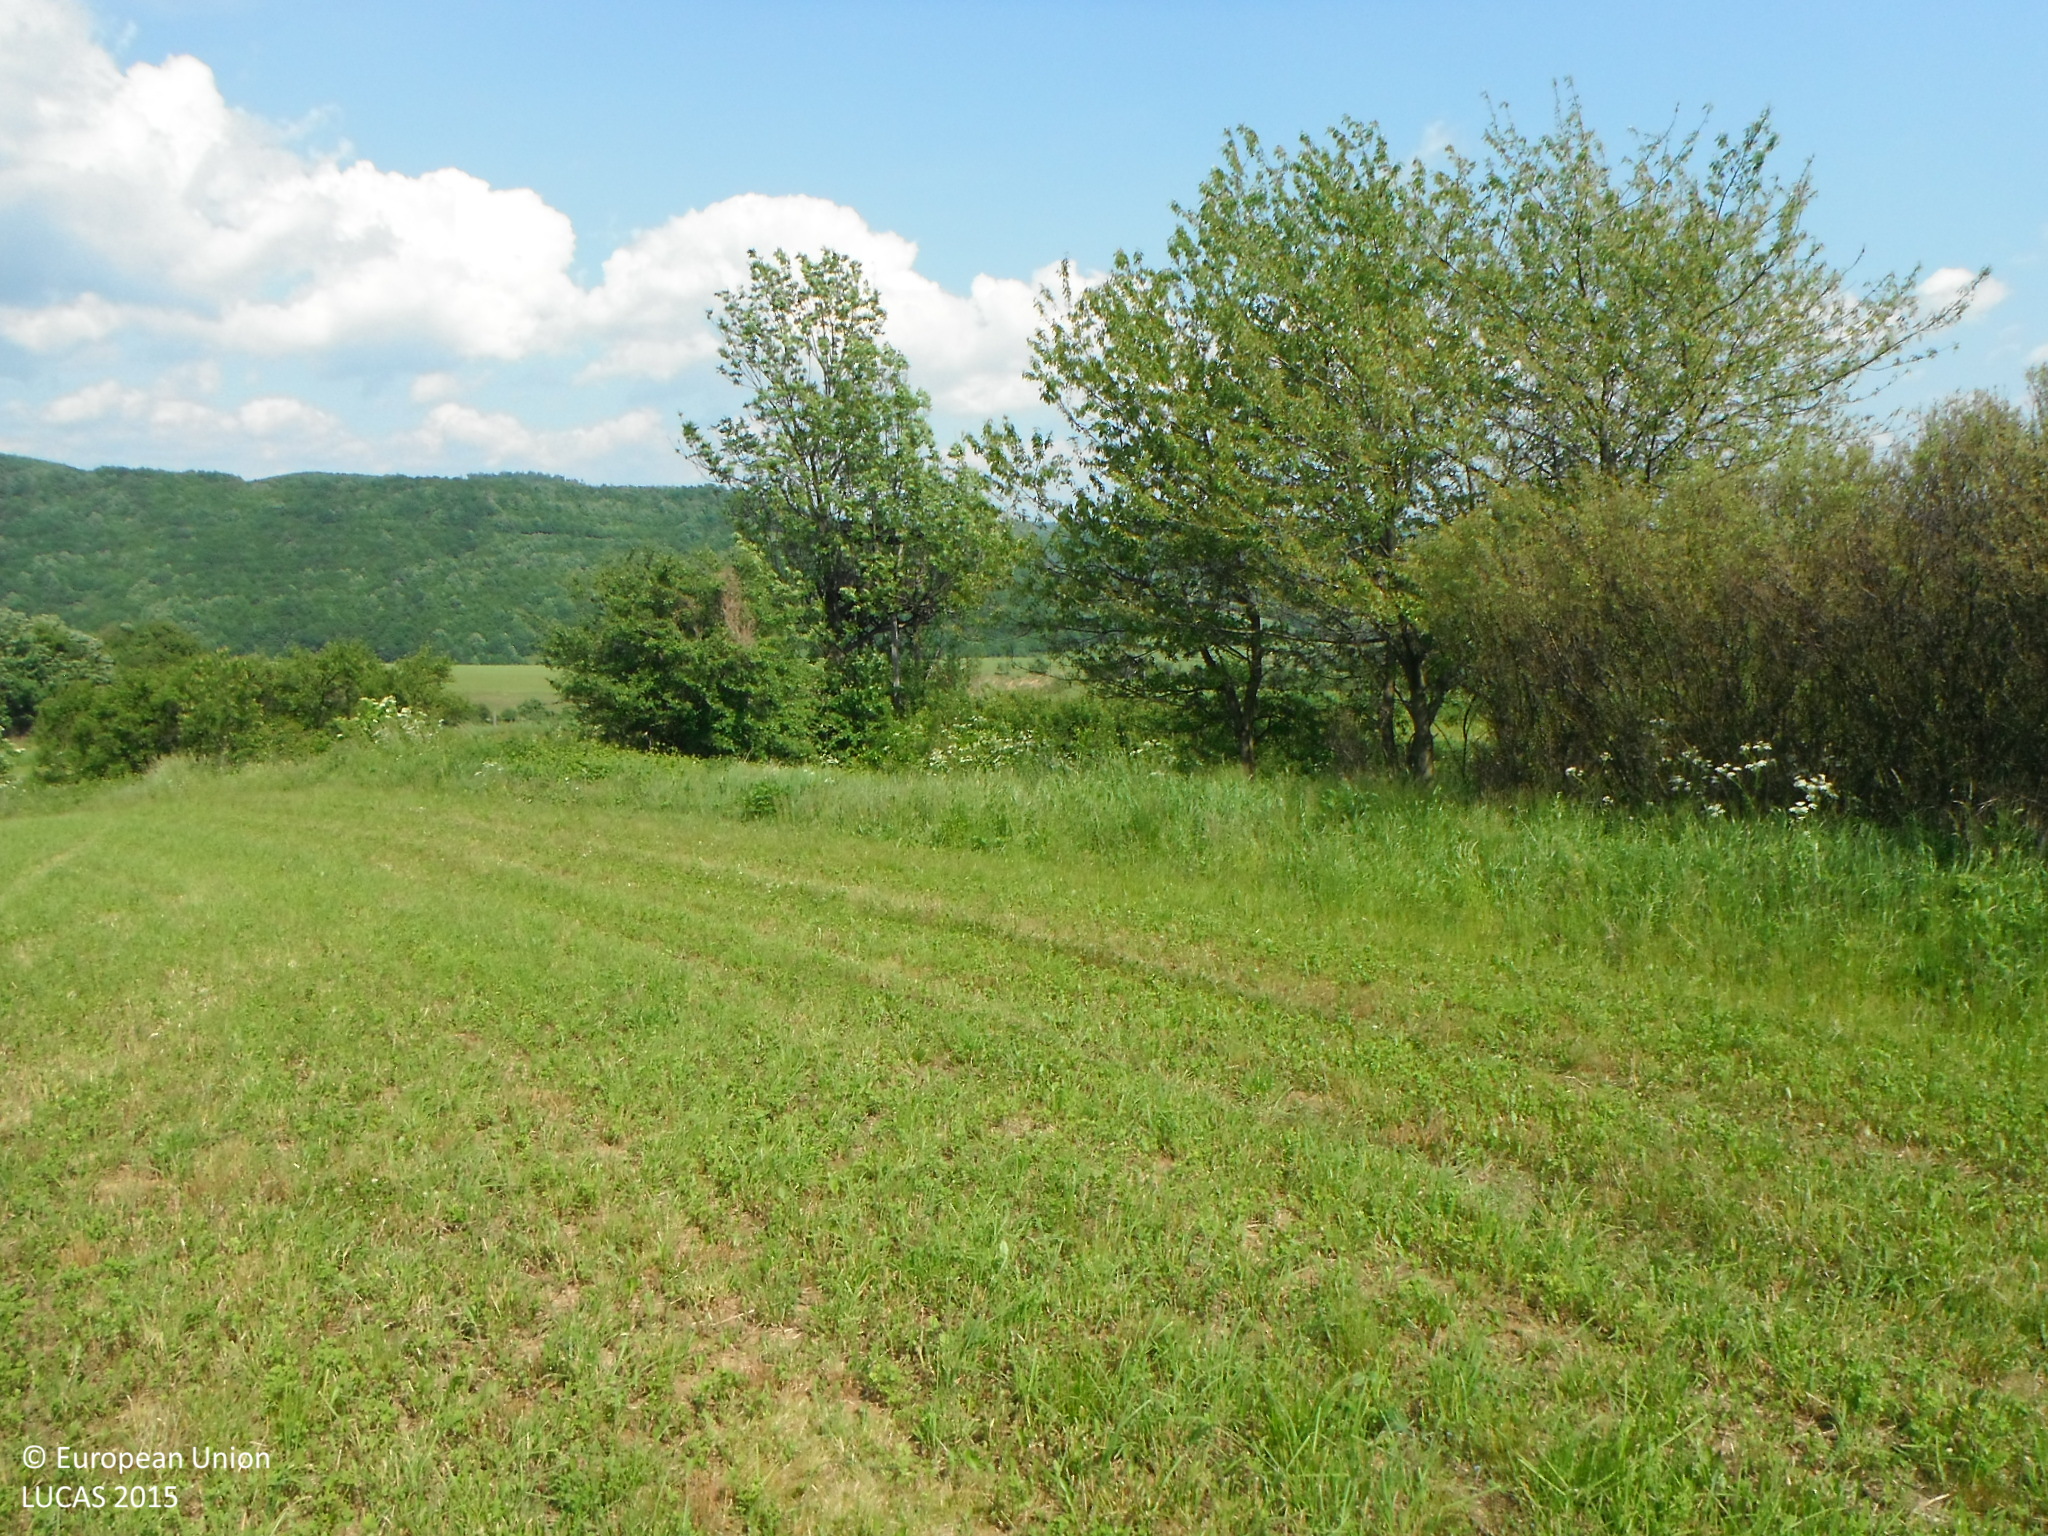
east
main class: Cropland
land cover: Other leguminous and mixtures for fodder
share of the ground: > 75 %
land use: Agriculture (excluding fallow land and kitchen gardens)
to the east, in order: Other leguminous and mixtures for fodder; Grass margins; Shrubland without tree cover; Tracks; Shrubland with sparse tree cover; Other leguminous and mixtures for fodder; Fences; Other leguminous and mixtures for fodder
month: May
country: SK
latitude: 48.3507
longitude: 18.9122
